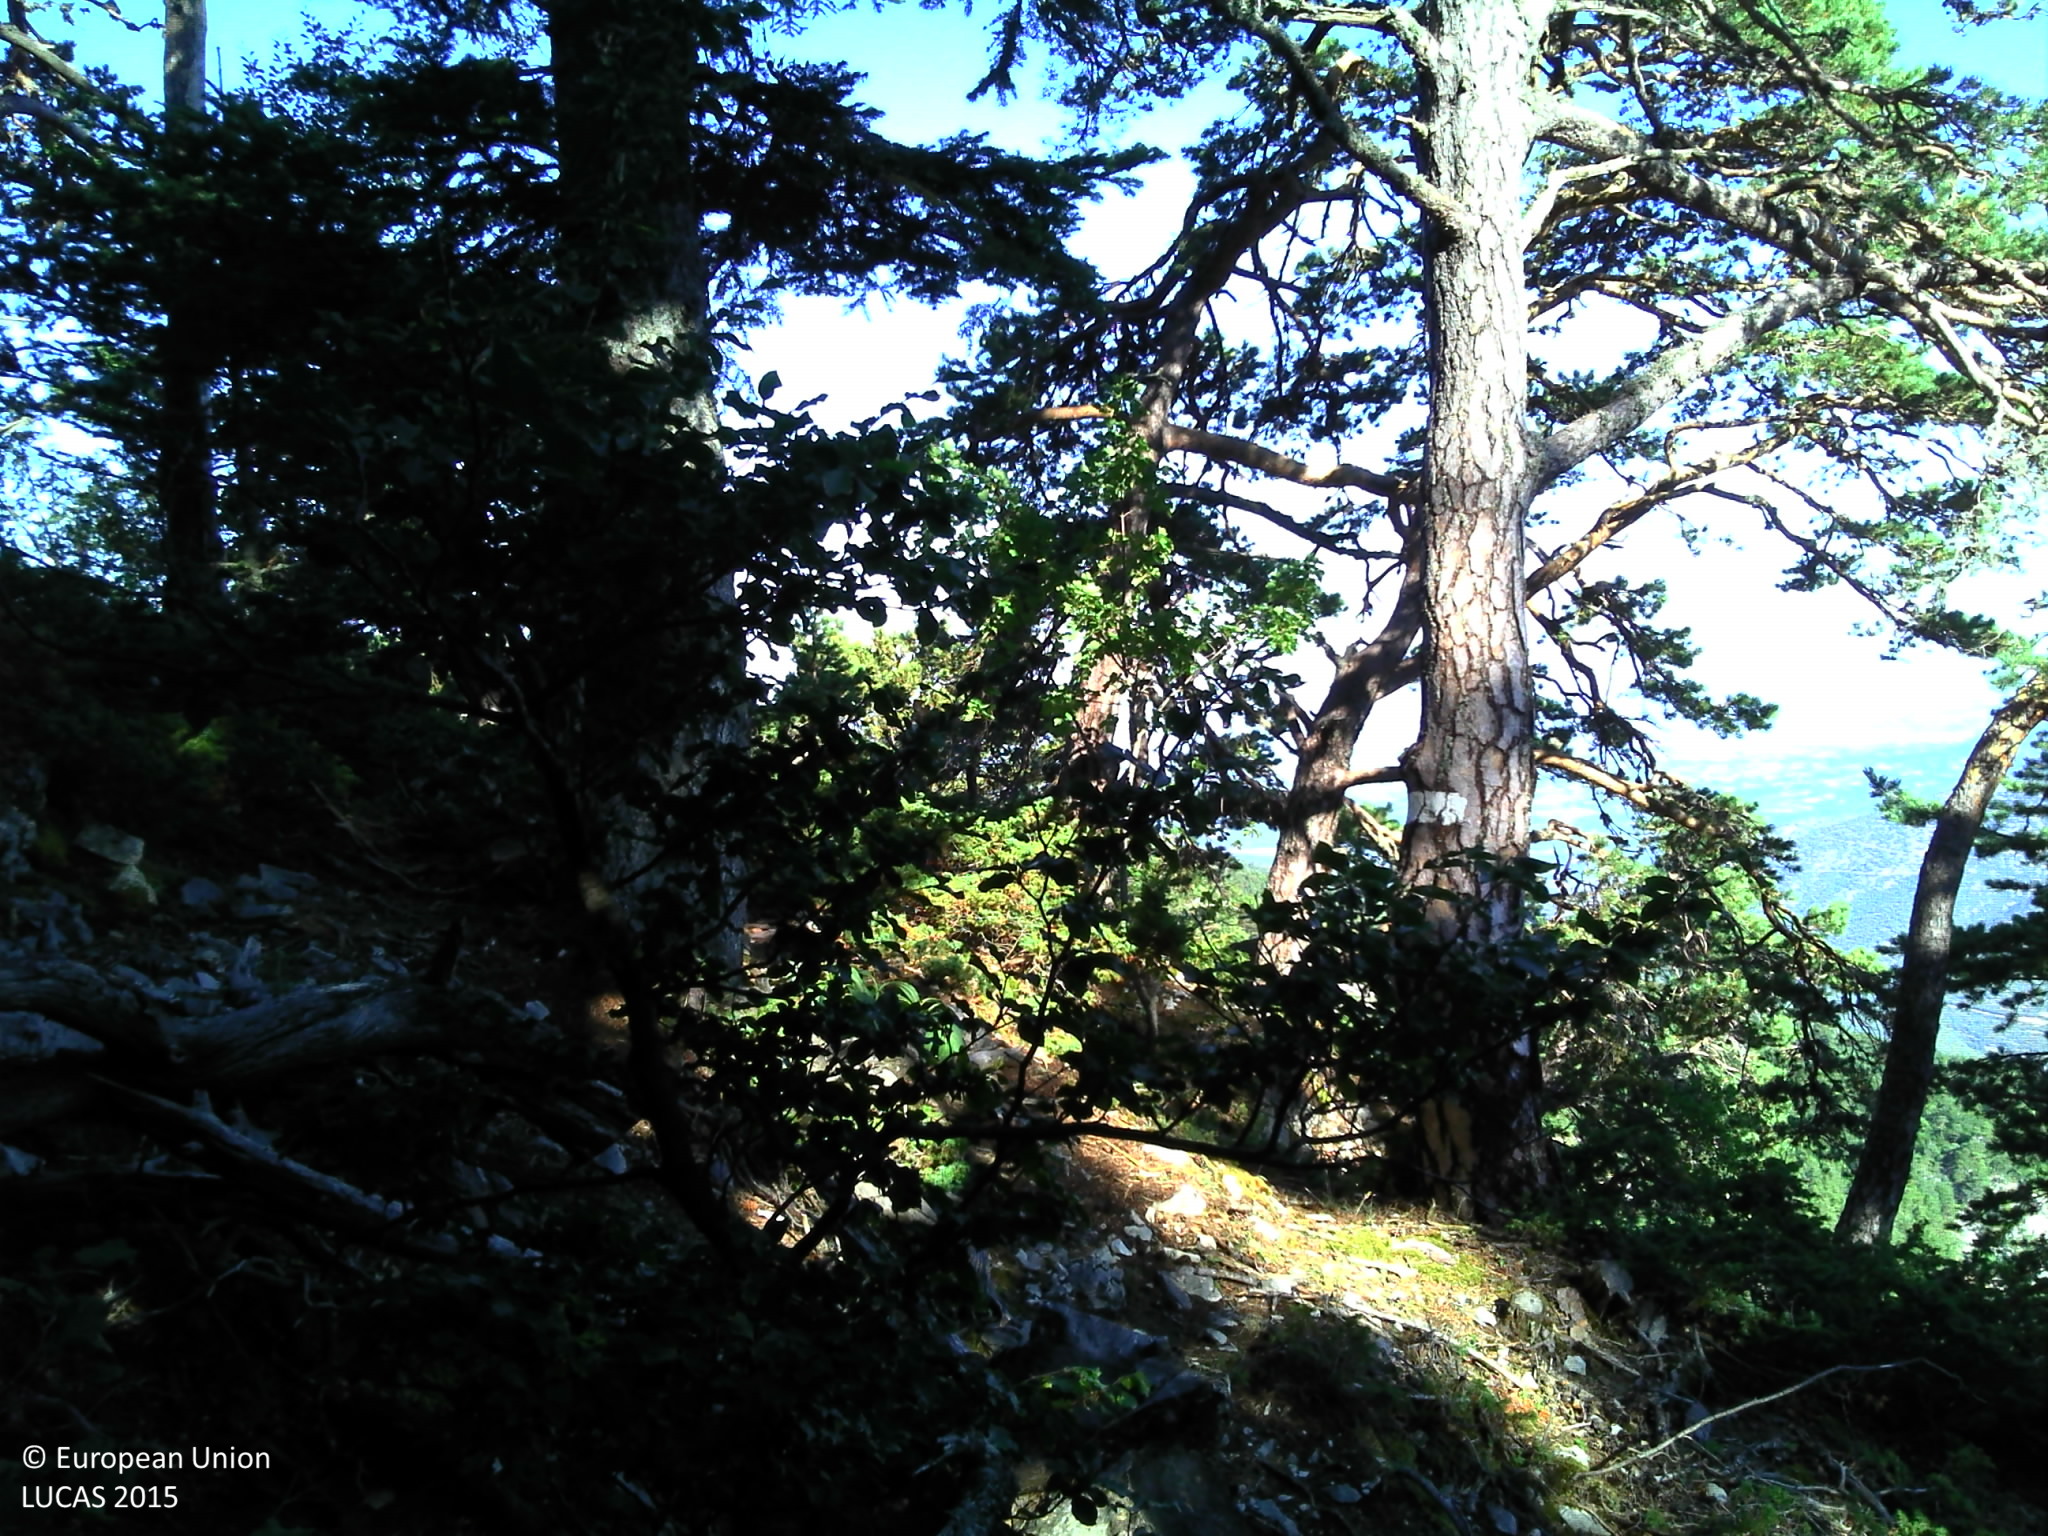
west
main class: Woodland
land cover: Pine dominated mixed woodland
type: coniferous forest of the mediterranean region
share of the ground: > 75 %
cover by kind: coniferous forest trees 30 %, lichens and mosses 20 %, unconsolidated bare surface 20 %, broadleaved forest trees 15 %, consolidated bare surface 10 %, shrubs 5 %
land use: Forestry
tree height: > 5 m
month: July
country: FR
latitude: 44.1884
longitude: 5.2664
